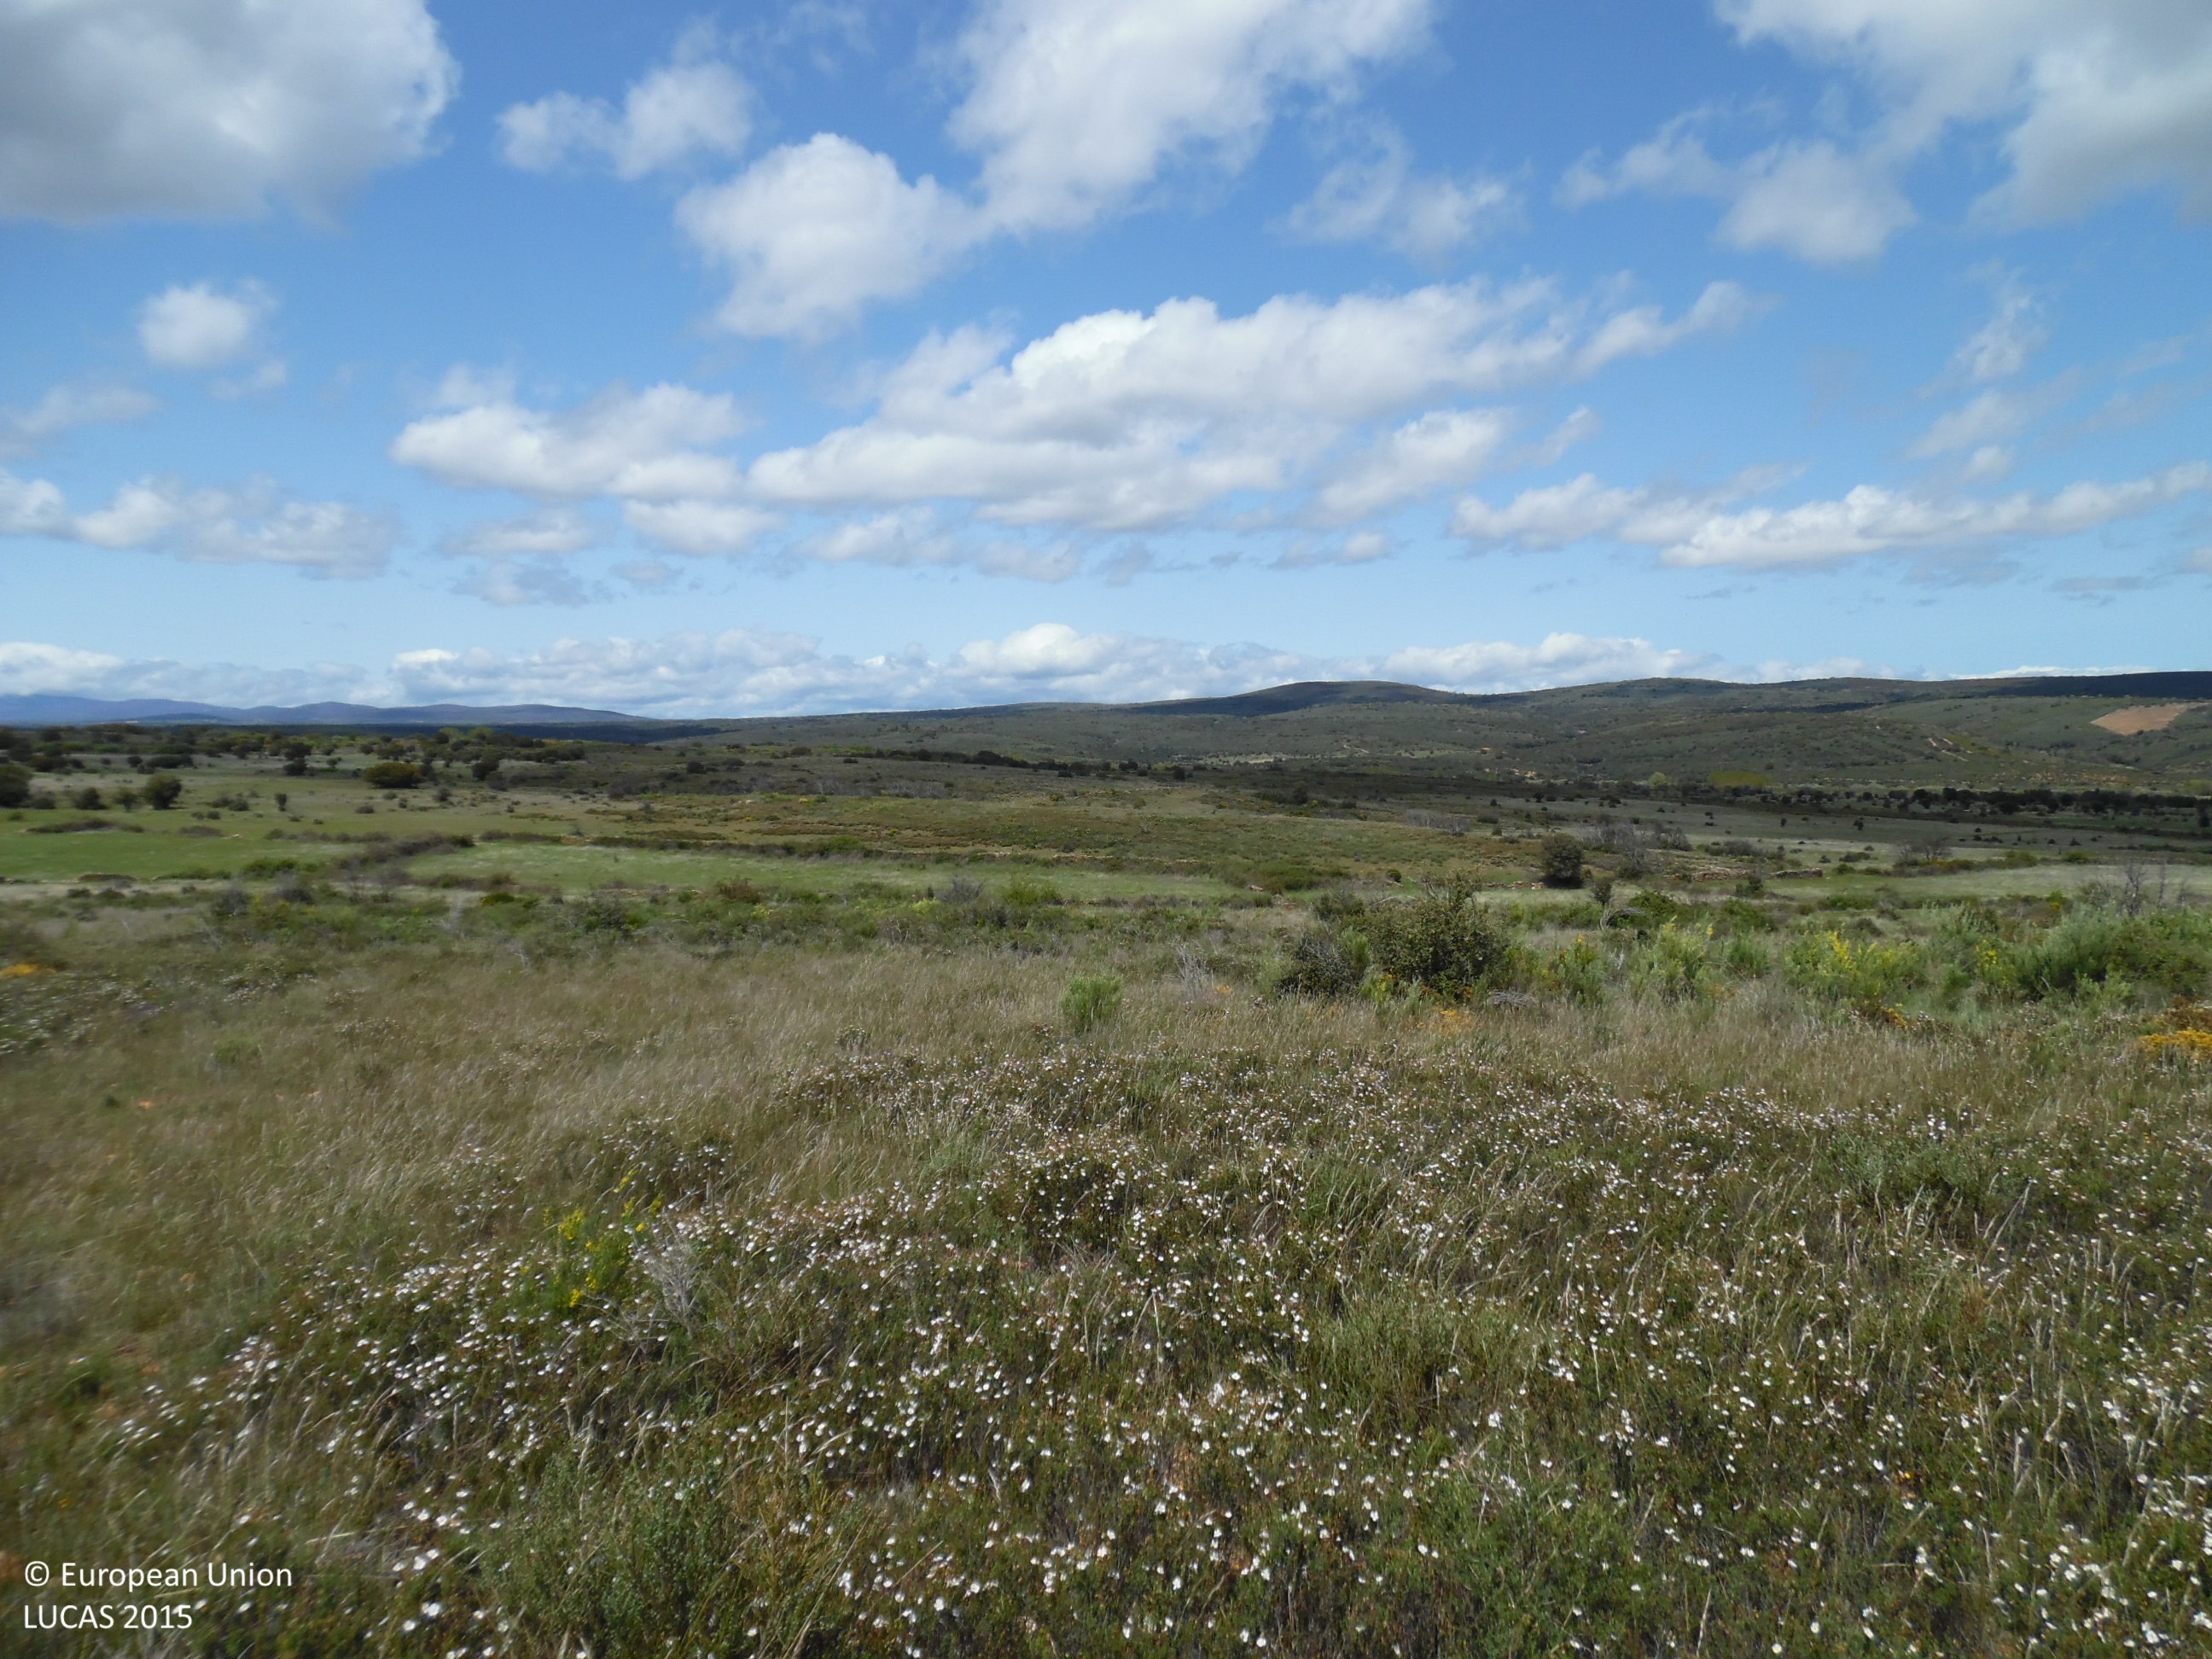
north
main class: Shrubland
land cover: Shrubland without tree cover
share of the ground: > 75 %
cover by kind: shrubs 90 %, herbaceous plants 10 %
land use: Abandoned areas
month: May
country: ES
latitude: 42.3283
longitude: -6.1120
